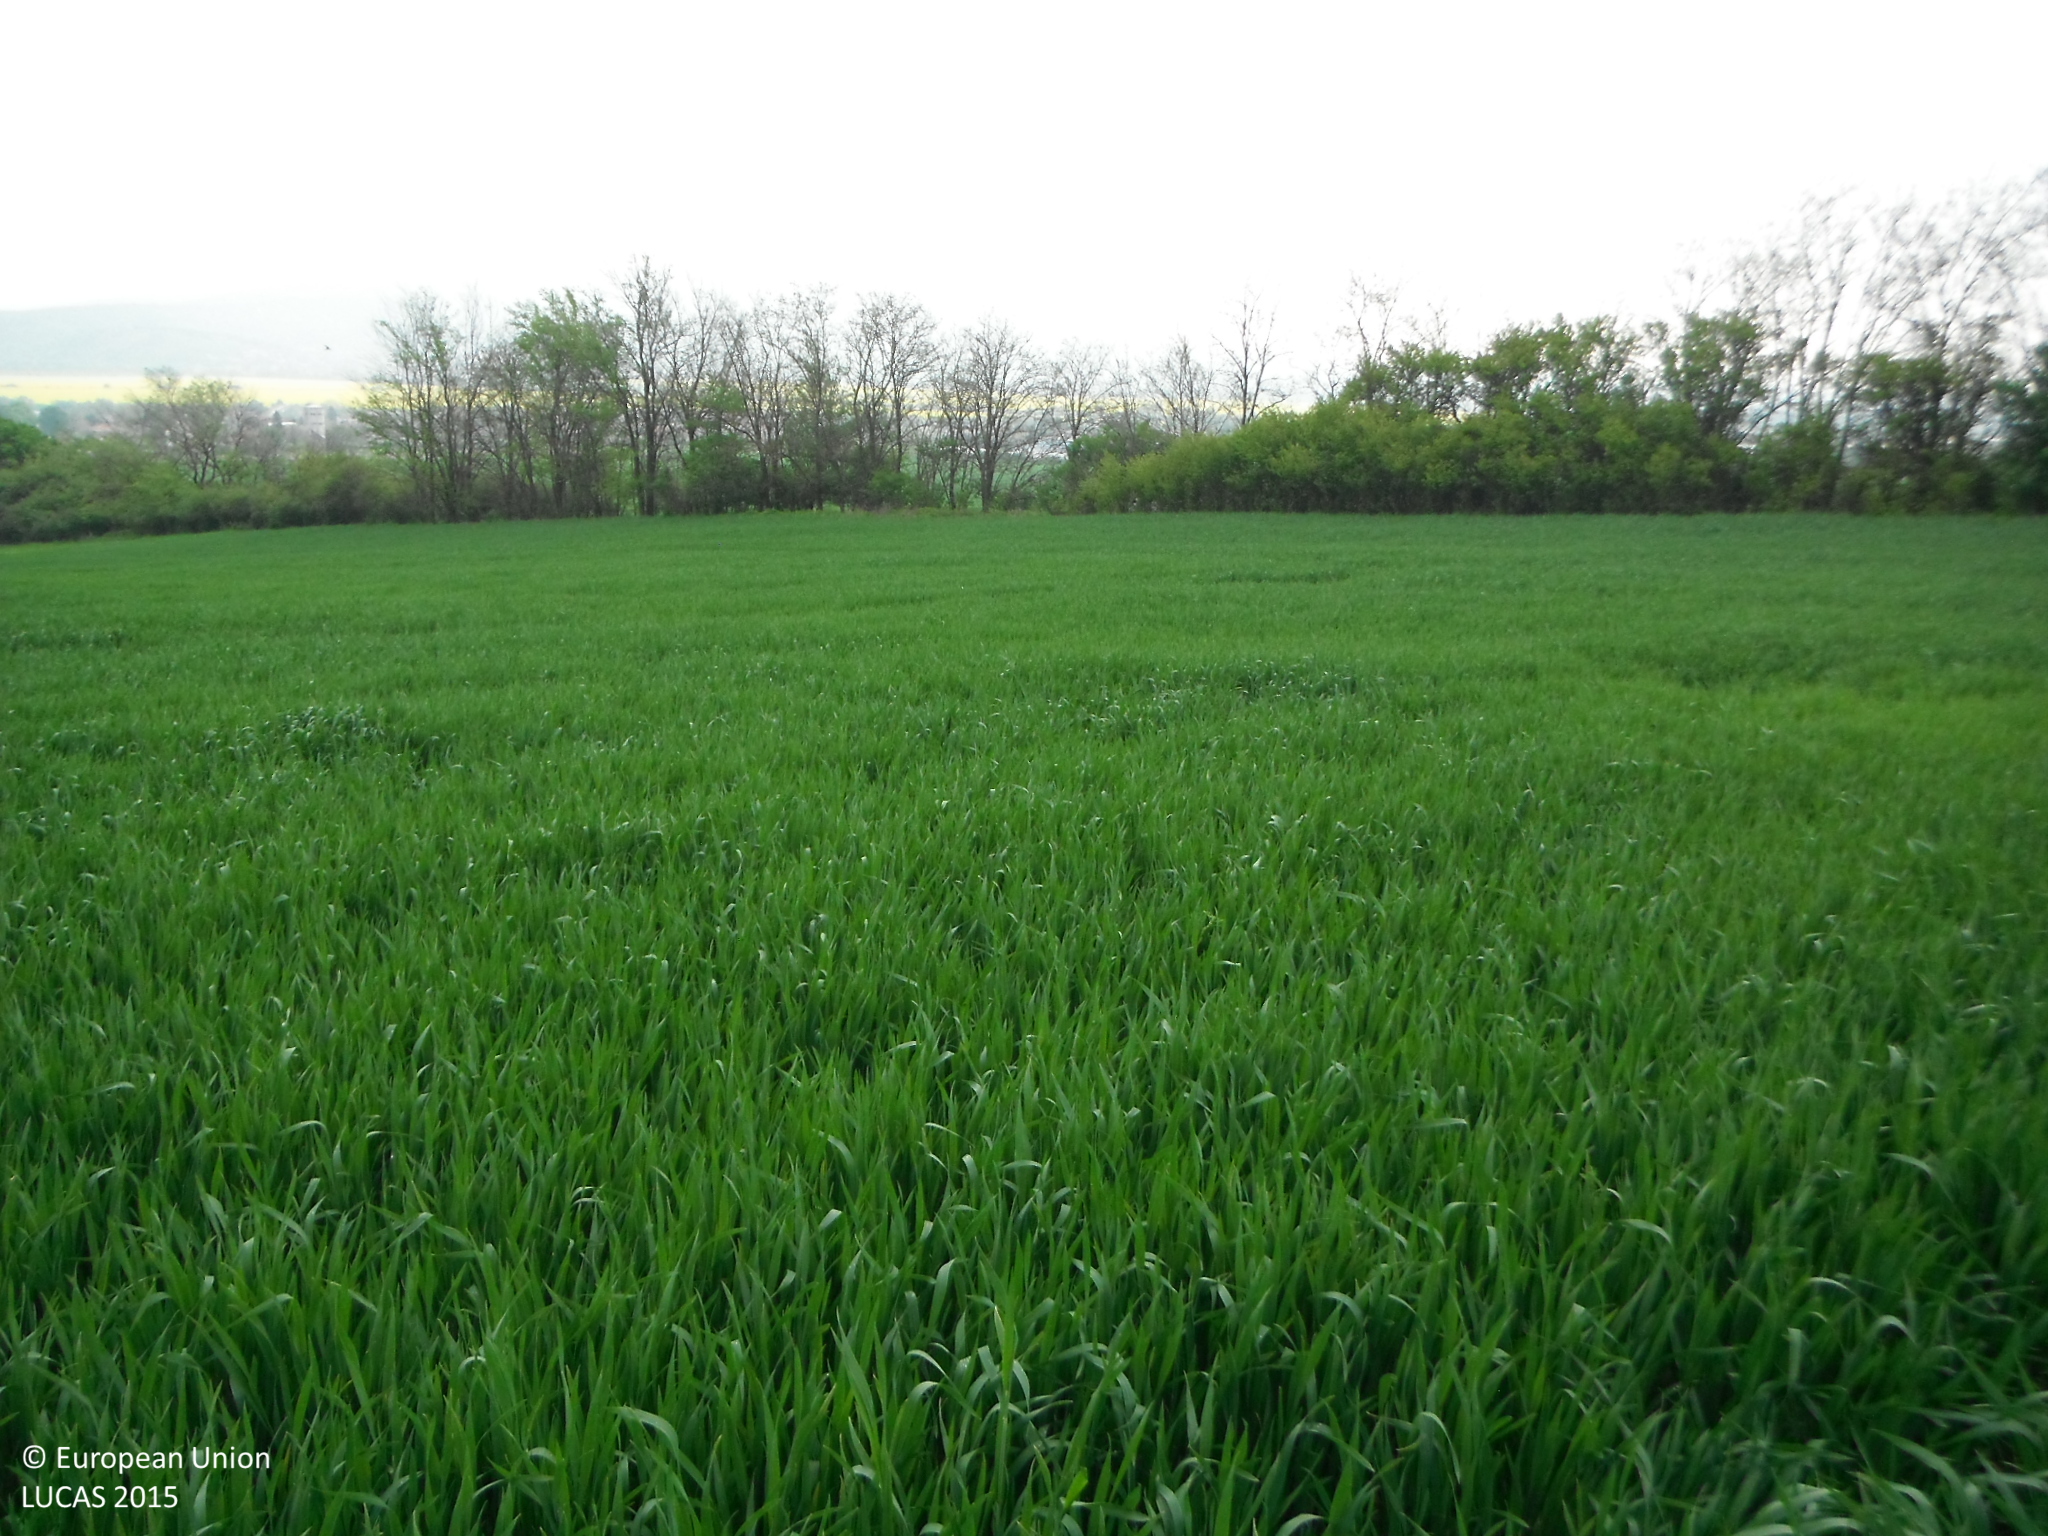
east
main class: Cropland
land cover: Common wheat
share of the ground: > 75 %
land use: Agriculture (excluding fallow land and kitchen gardens)
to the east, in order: Common wheat; Broadleaved woodland; Common wheat
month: May
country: SK
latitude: 48.3473
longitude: 18.0148
